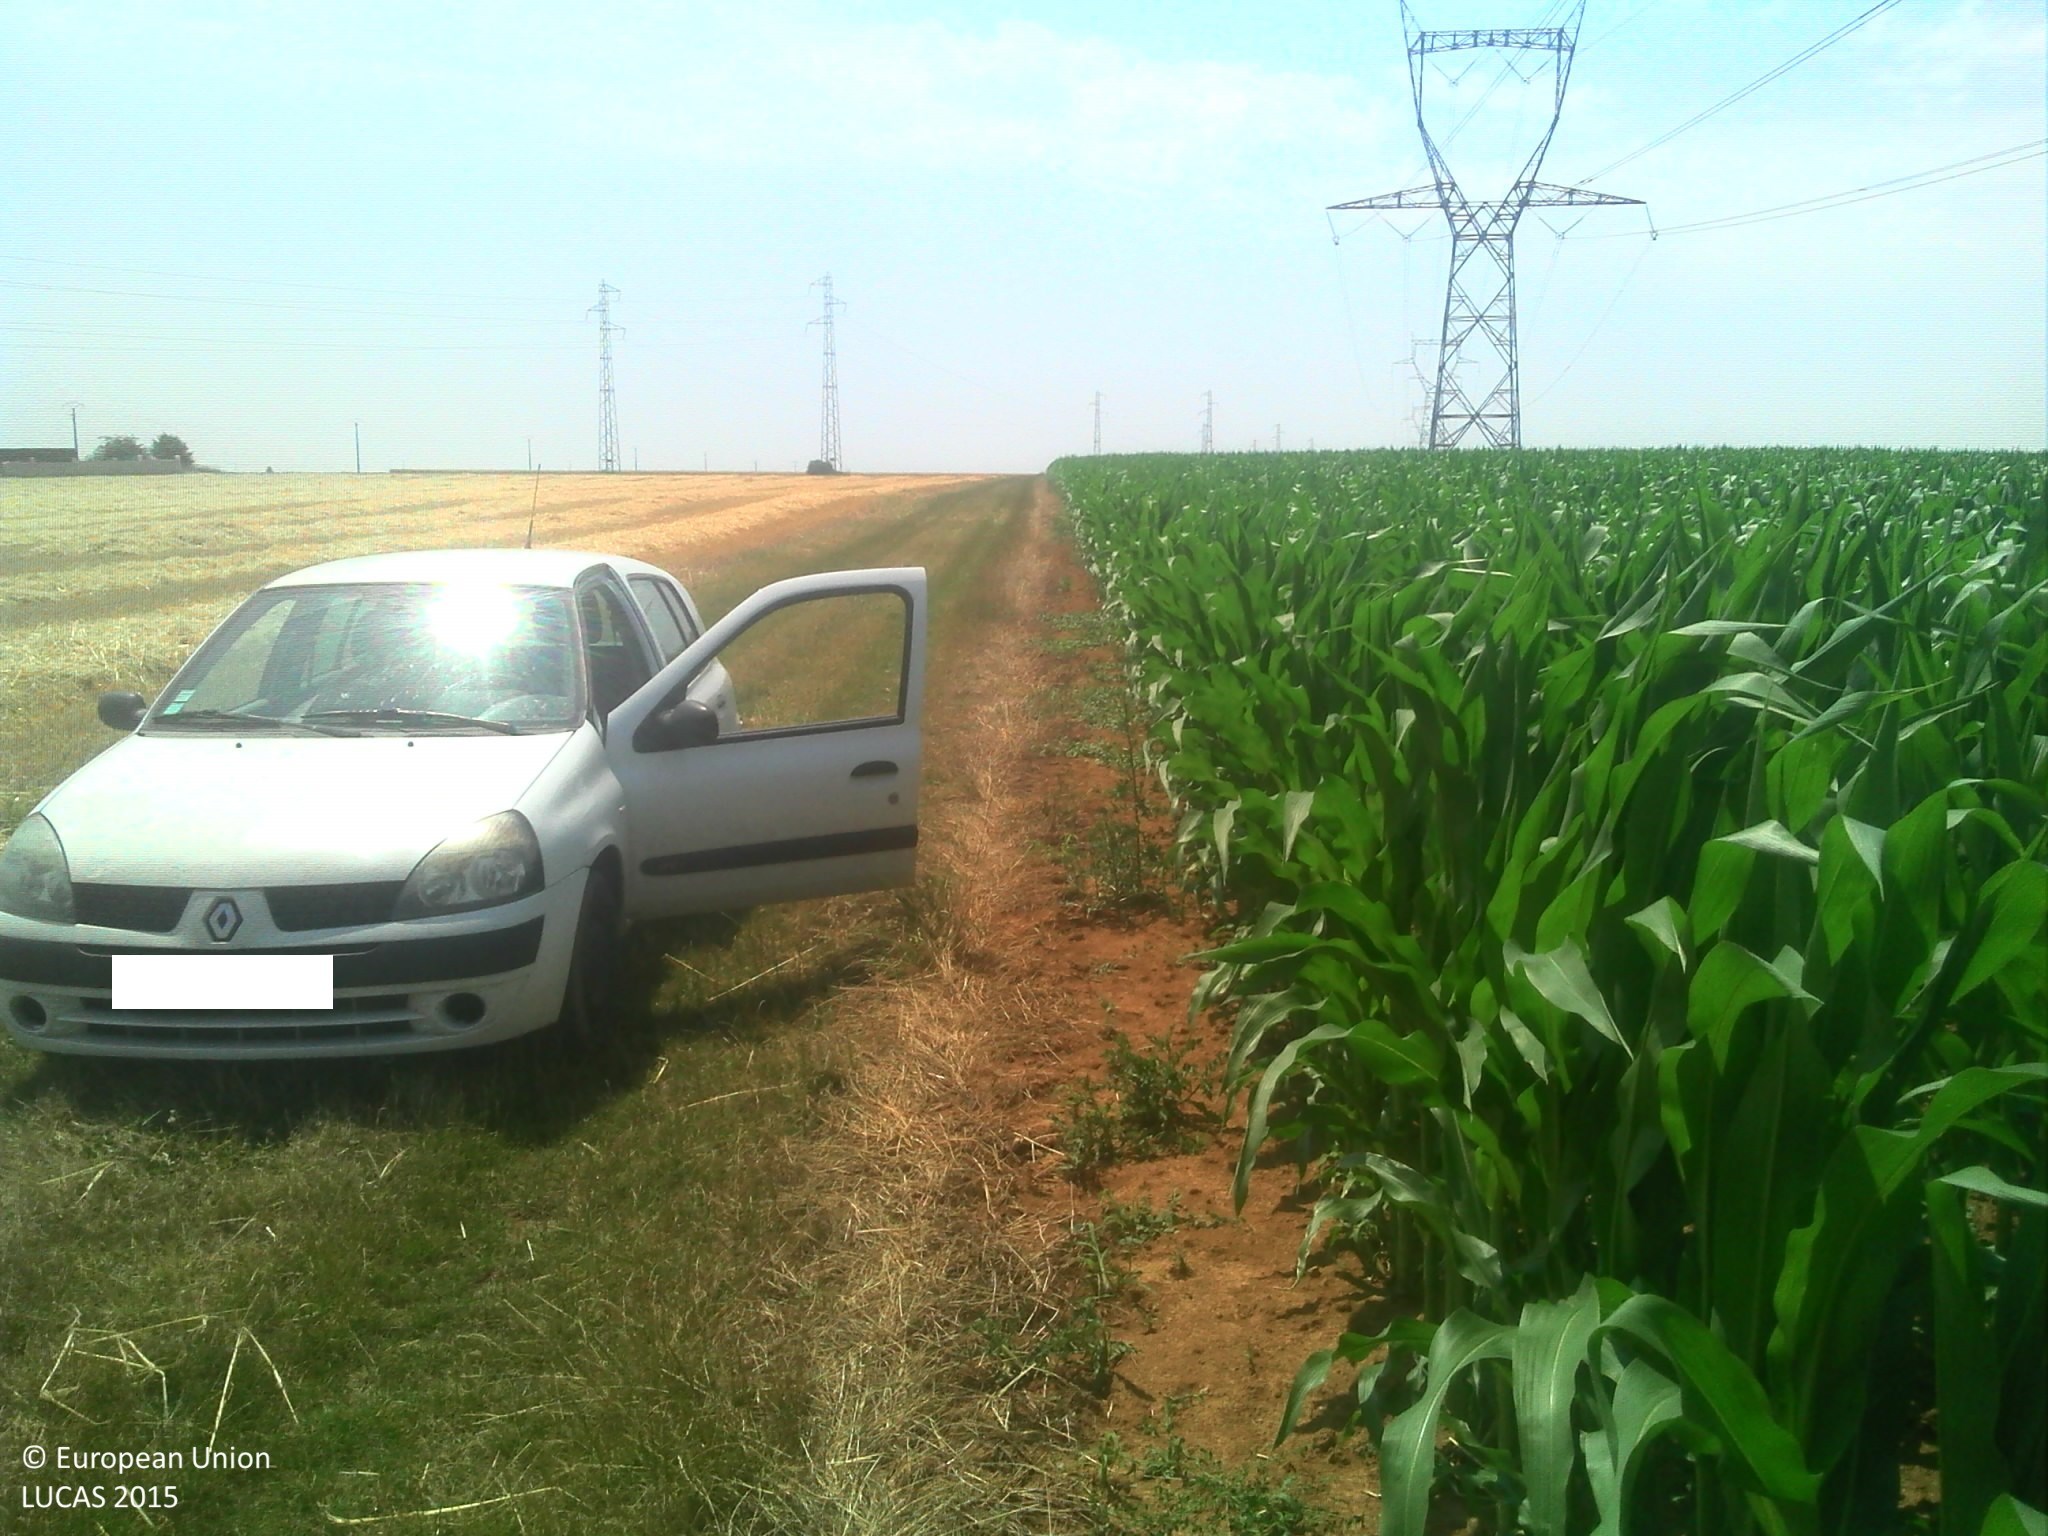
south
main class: Cropland
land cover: Maize
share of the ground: > 75 %
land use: Agriculture (excluding fallow land and kitchen gardens)
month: July
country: FR
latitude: 47.6673
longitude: 1.3683
